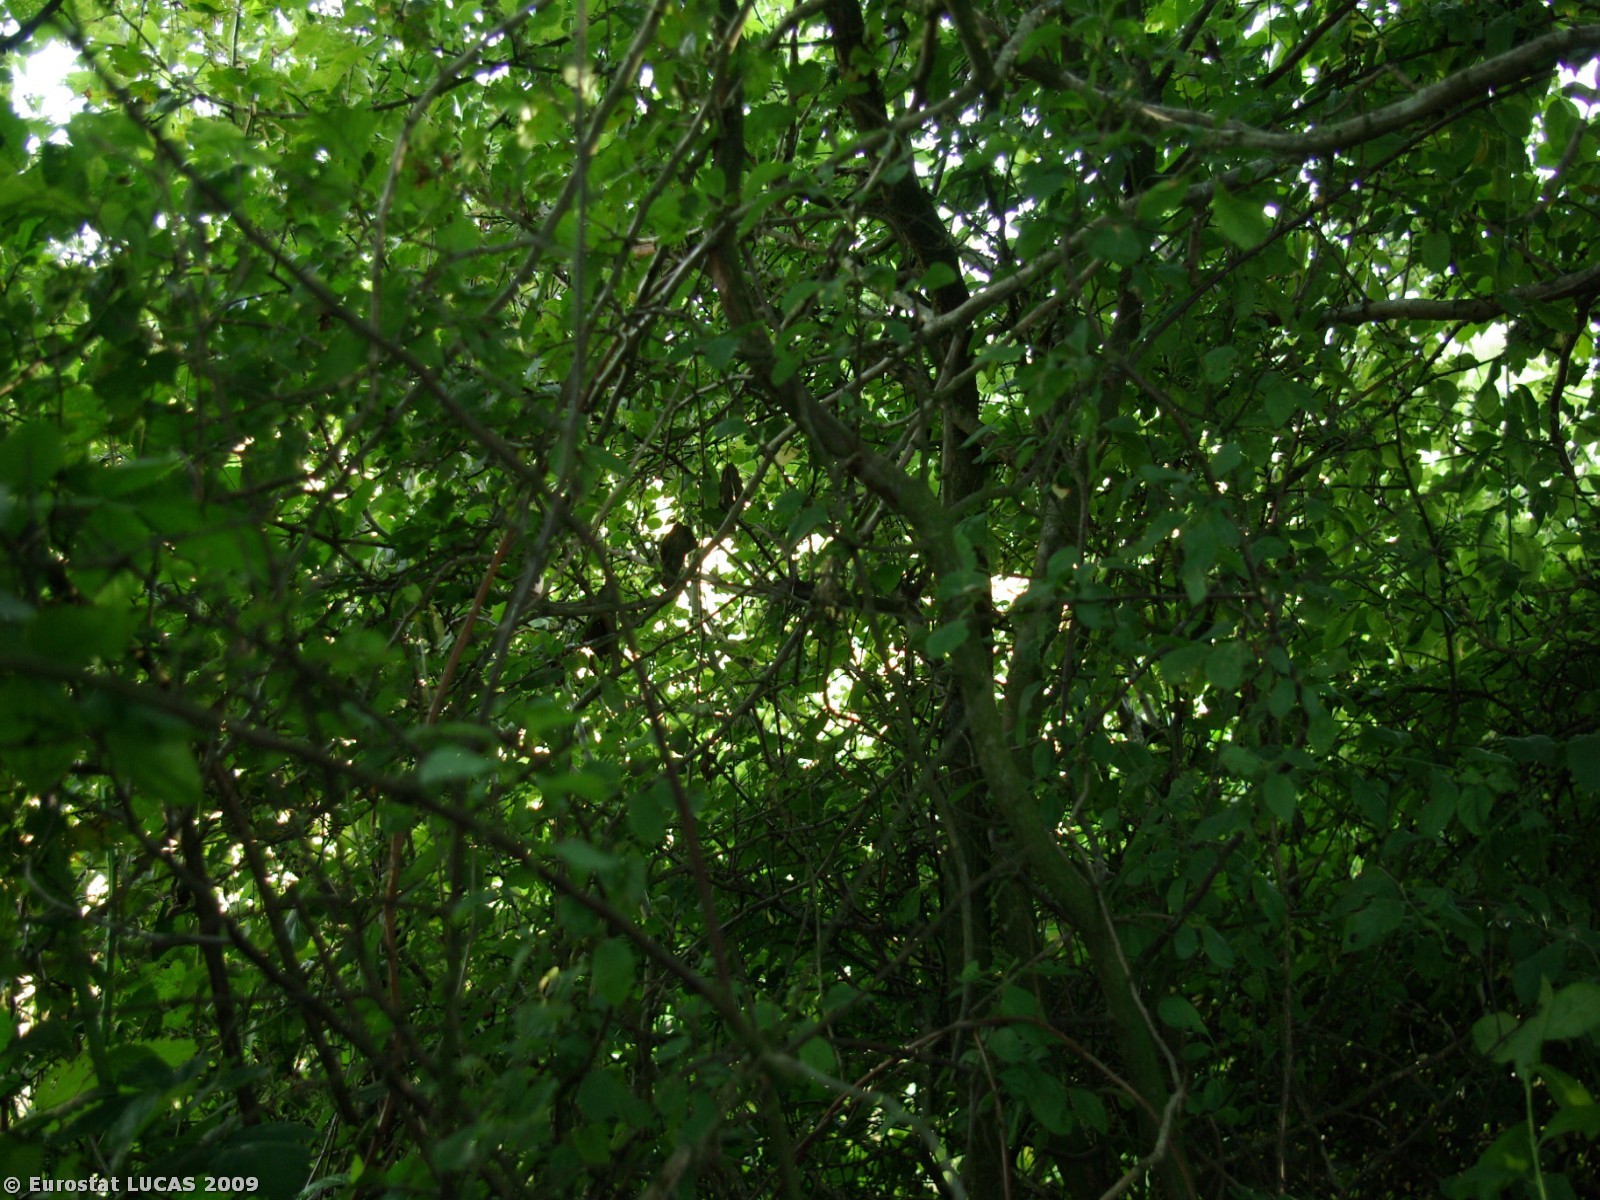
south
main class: Woodland
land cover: Mixed woodland
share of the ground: > 75 %
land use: Unused
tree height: > 5 m
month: July
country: DK
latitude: 54.9815
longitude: 9.2974
